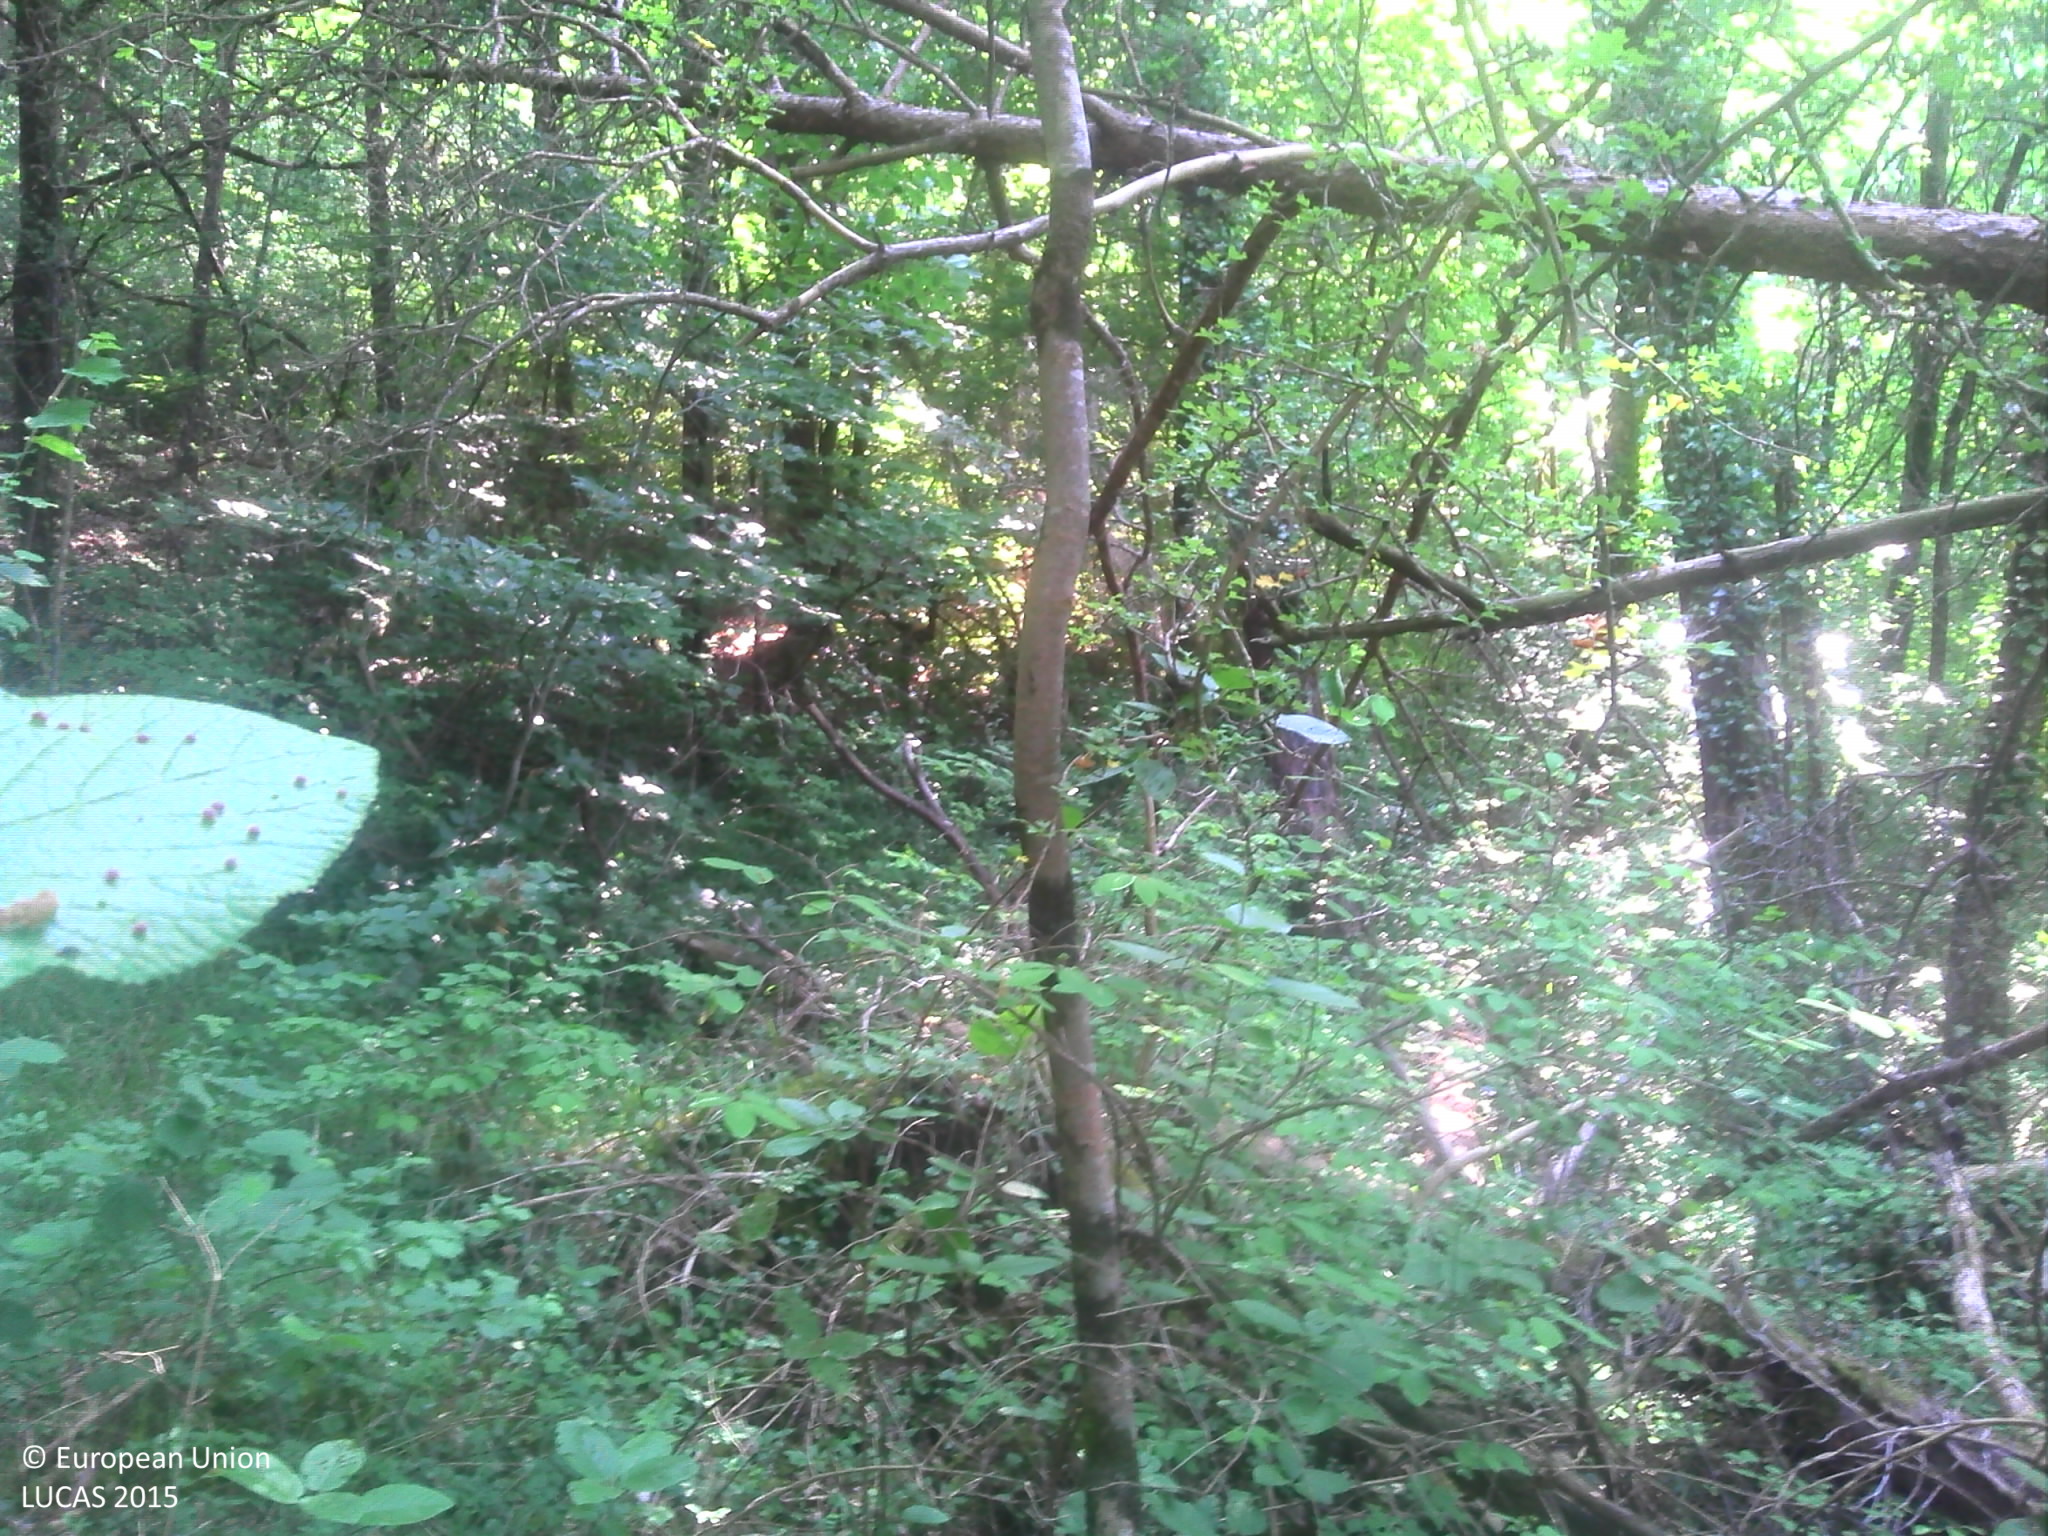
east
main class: Woodland
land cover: Pine dominated coniferous woodland
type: beech forest
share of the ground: > 75 %
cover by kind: coniferous forest trees 70 %, broadleaved forest trees 20 %, herbaceous plants 5 %, lichens and mosses 5 %
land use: Forestry
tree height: > 5 m
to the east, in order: Pine dominated coniferous woodland; Tracks; Pine dominated coniferous woodland
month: June
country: FR
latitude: 48.3705
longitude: 5.1797
